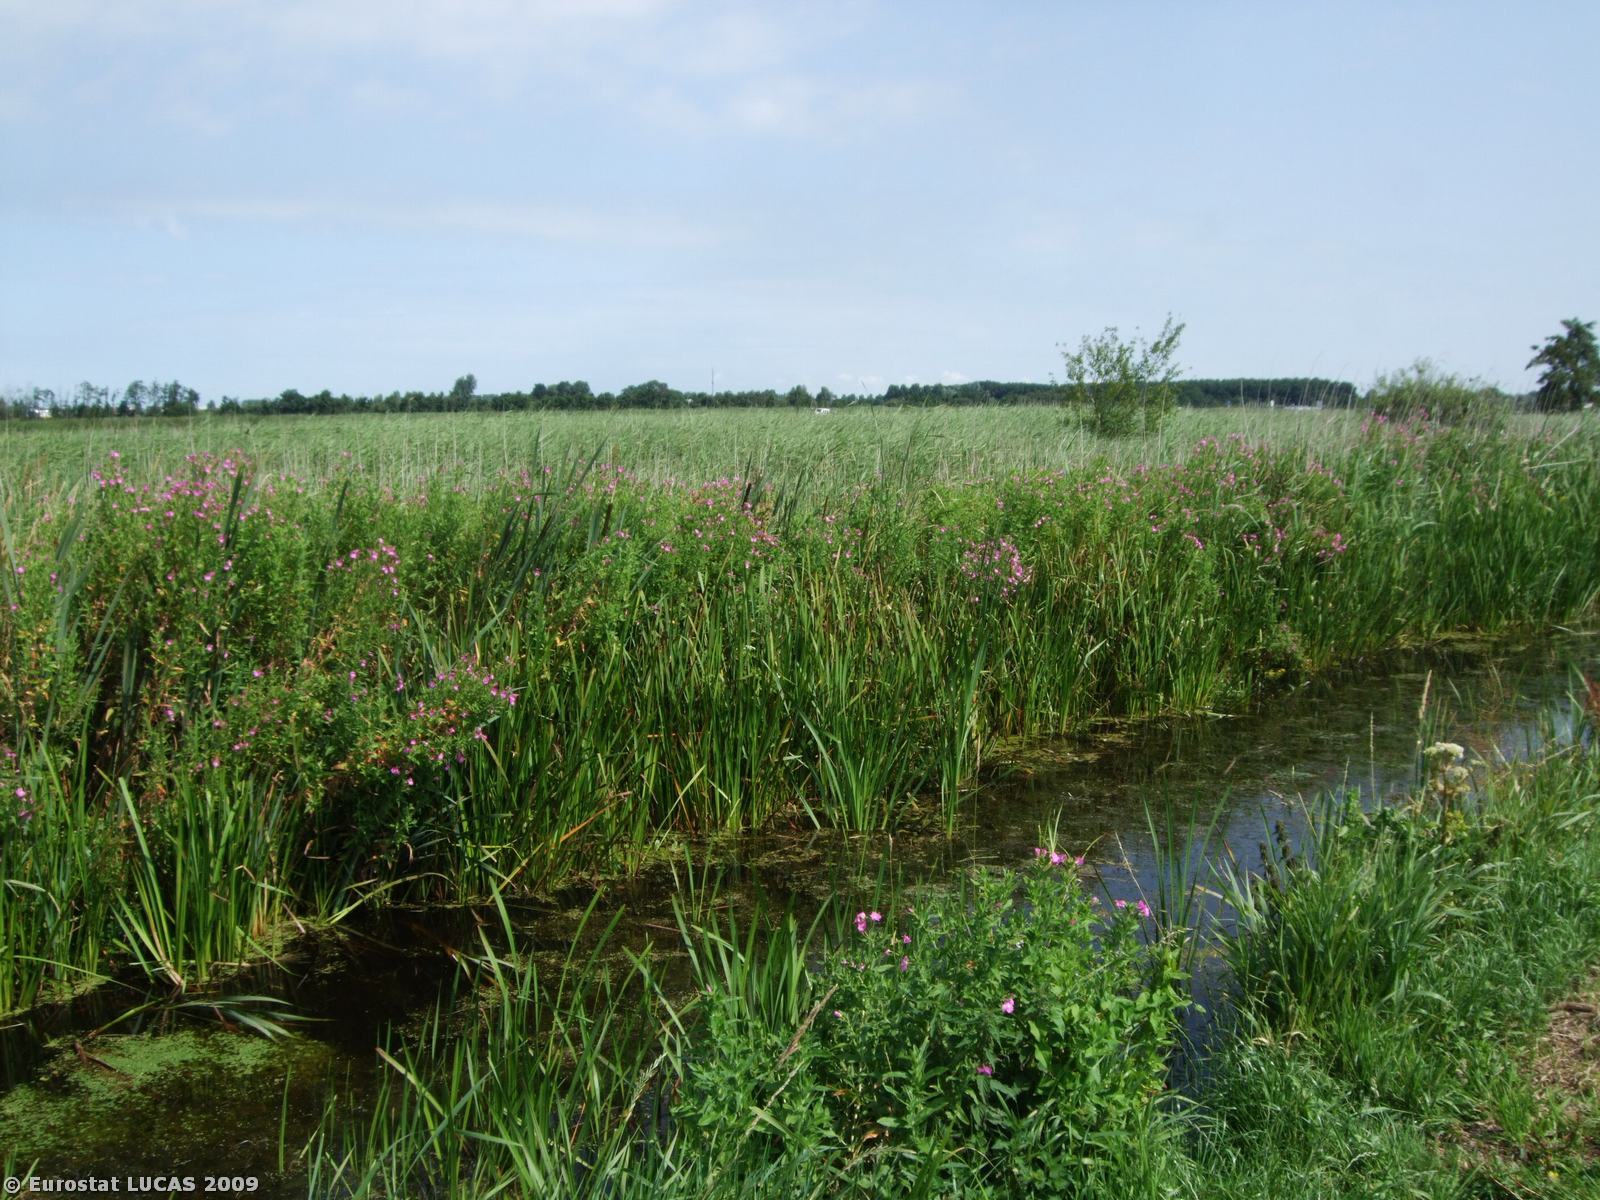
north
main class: Wetlands
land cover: Inland marshes
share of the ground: > 75 %
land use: Unused
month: May
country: NL
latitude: 53.0172
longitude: 5.6313
